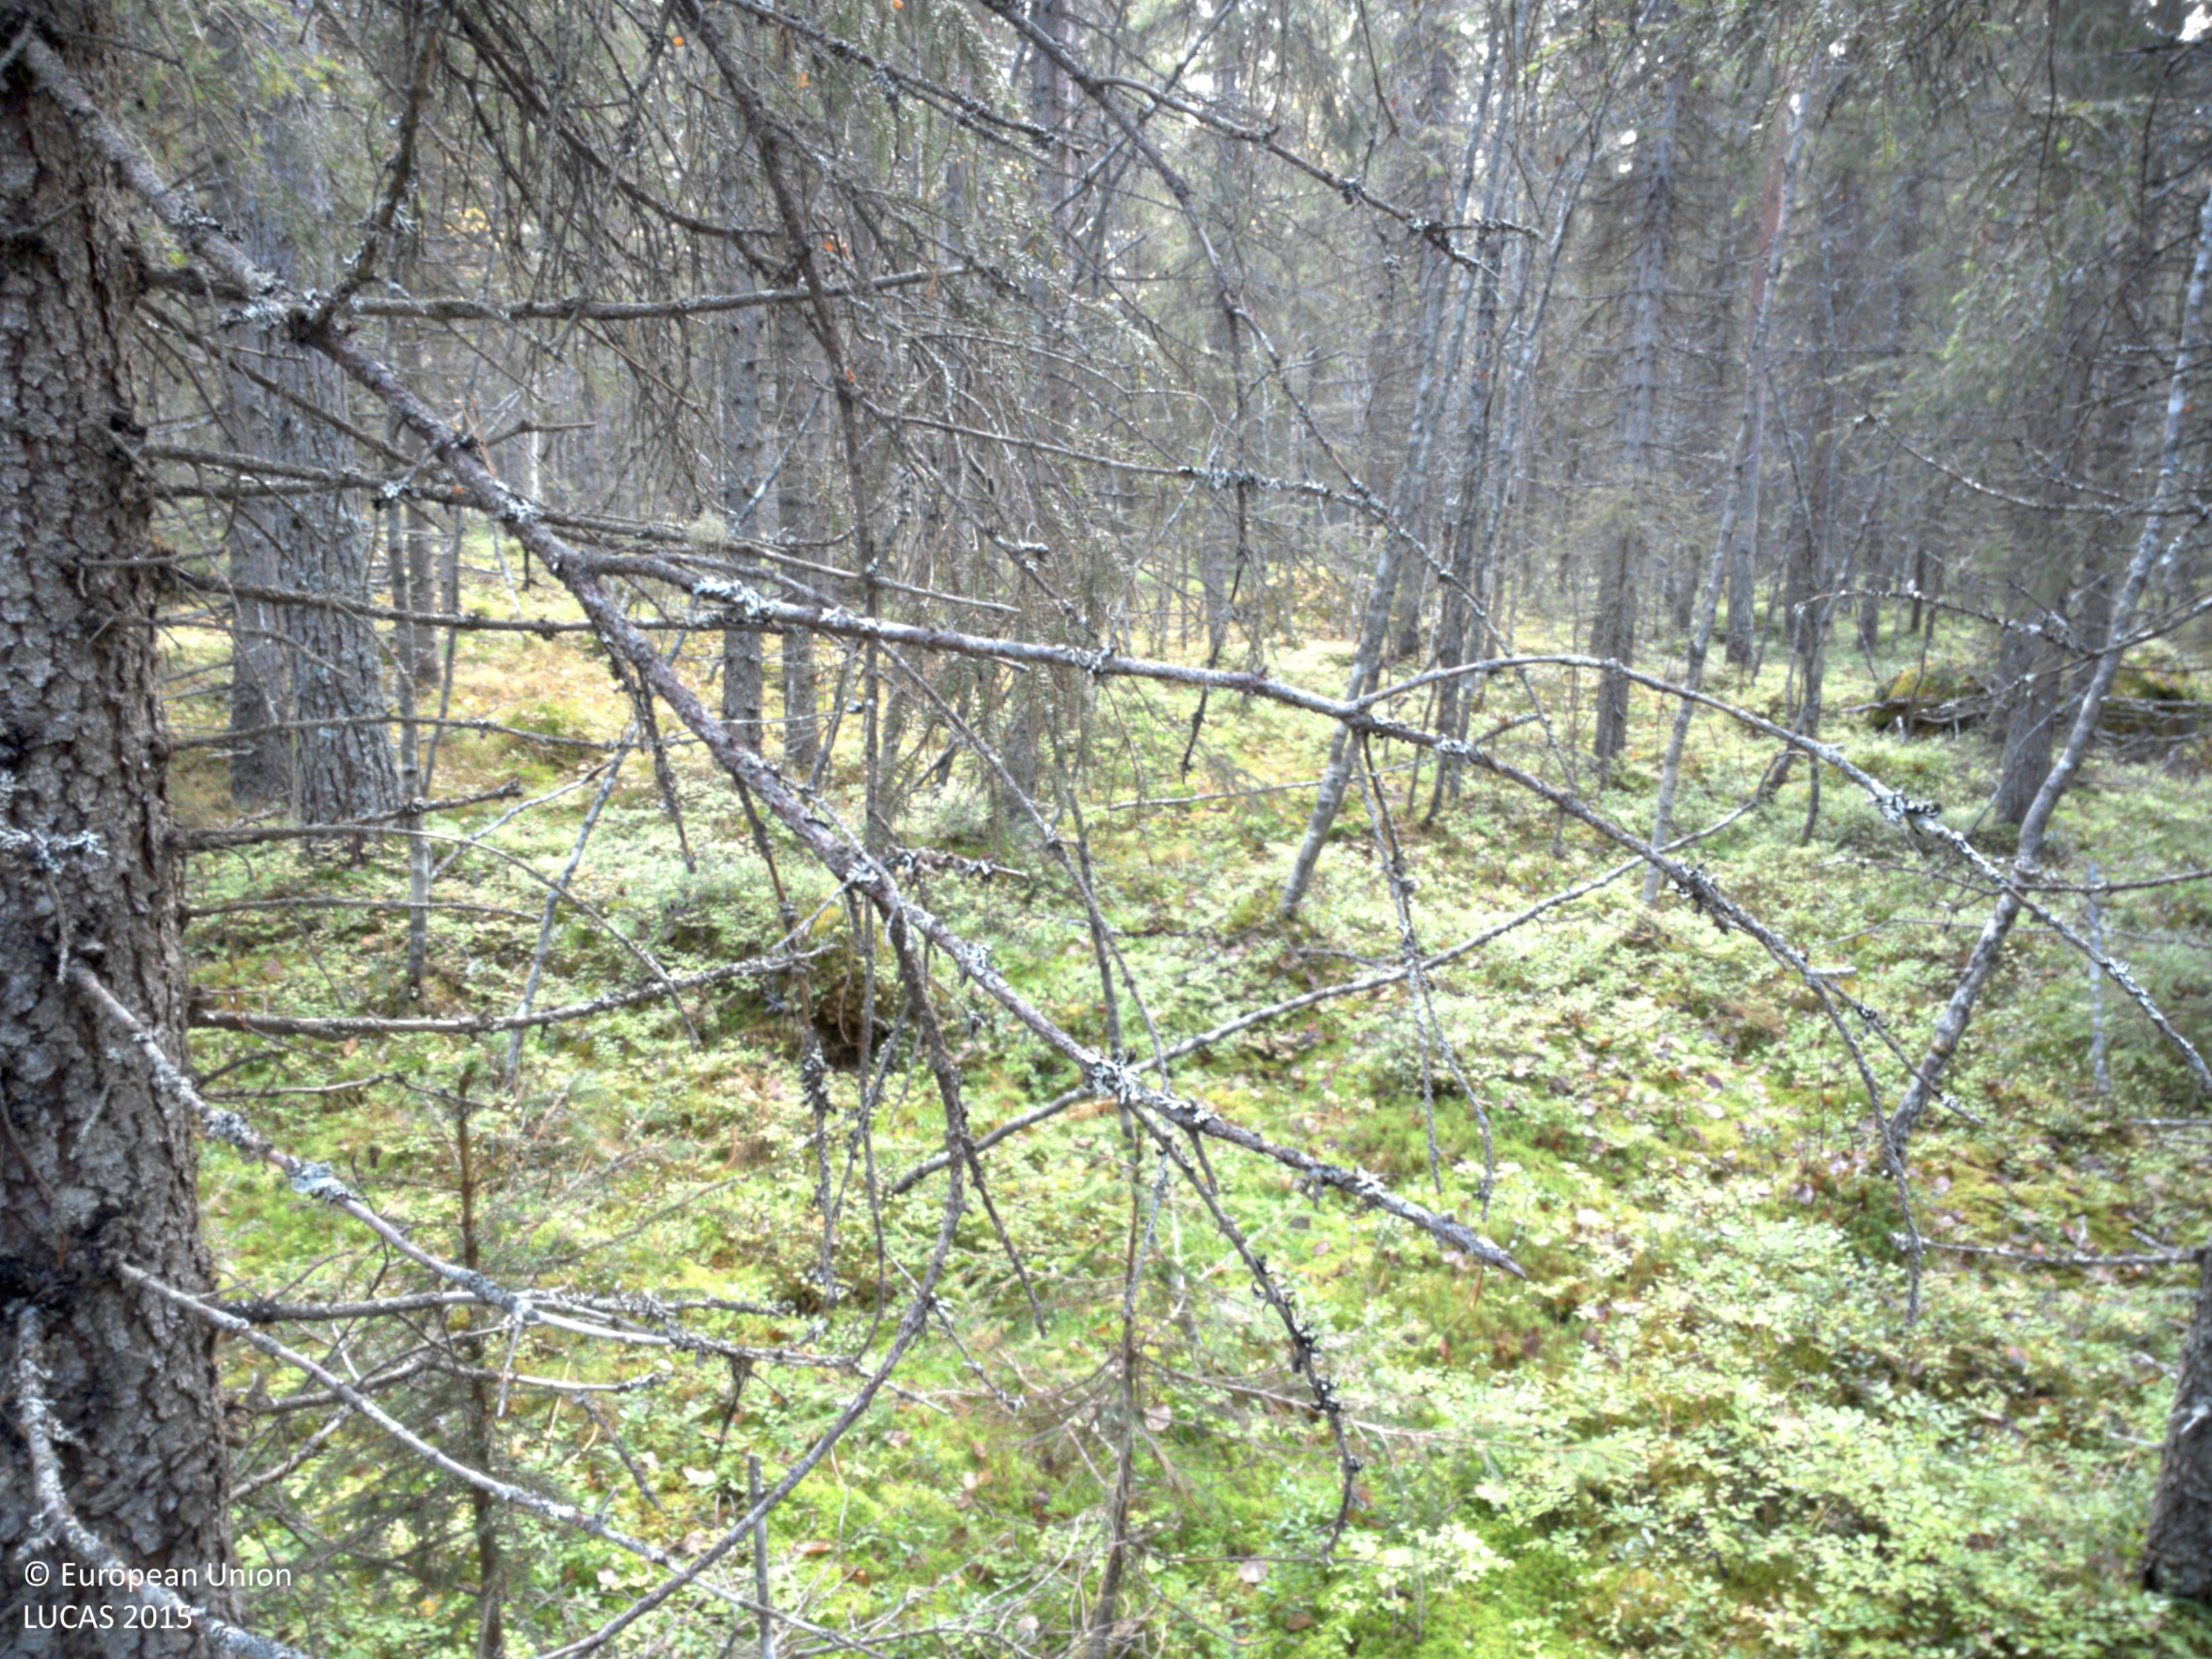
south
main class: Woodland
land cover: Spruce dominated coniferous woodland
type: boreal forest
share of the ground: > 75 %
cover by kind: coniferous forest trees 80 %, shrubs 10 %, broadleaved forest trees 5 %, lichens and mosses 5 %
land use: Forestry
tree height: > 5 m
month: September
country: SE
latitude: 65.0841
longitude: 18.4090
